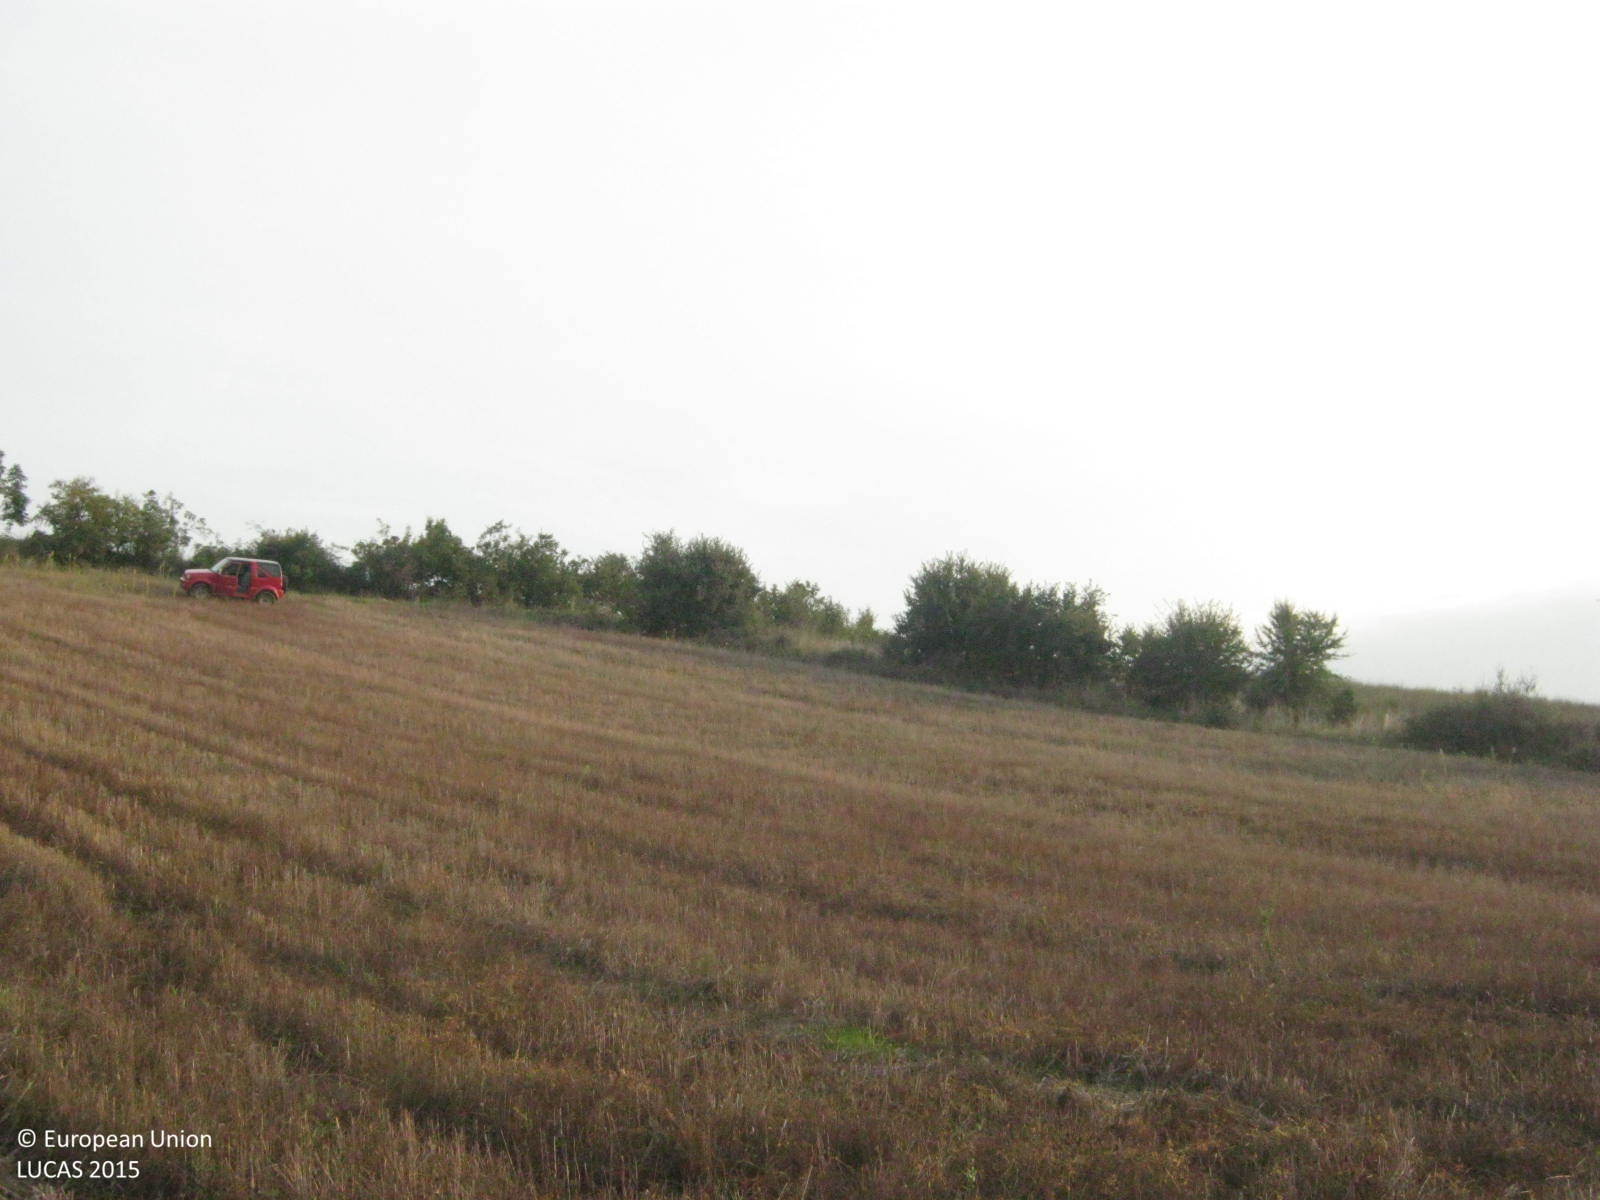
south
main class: Woodland
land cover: Broadleaved woodland
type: thermophilous deciduous forest
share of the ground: > 75 %
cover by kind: broadleaved forest trees 75 %, shrubs 15 %, herbaceous plants 10 %
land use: Semi-natural and natural areas not in use
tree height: > 5 m
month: October
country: GR
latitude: 40.9746
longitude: 22.9768
